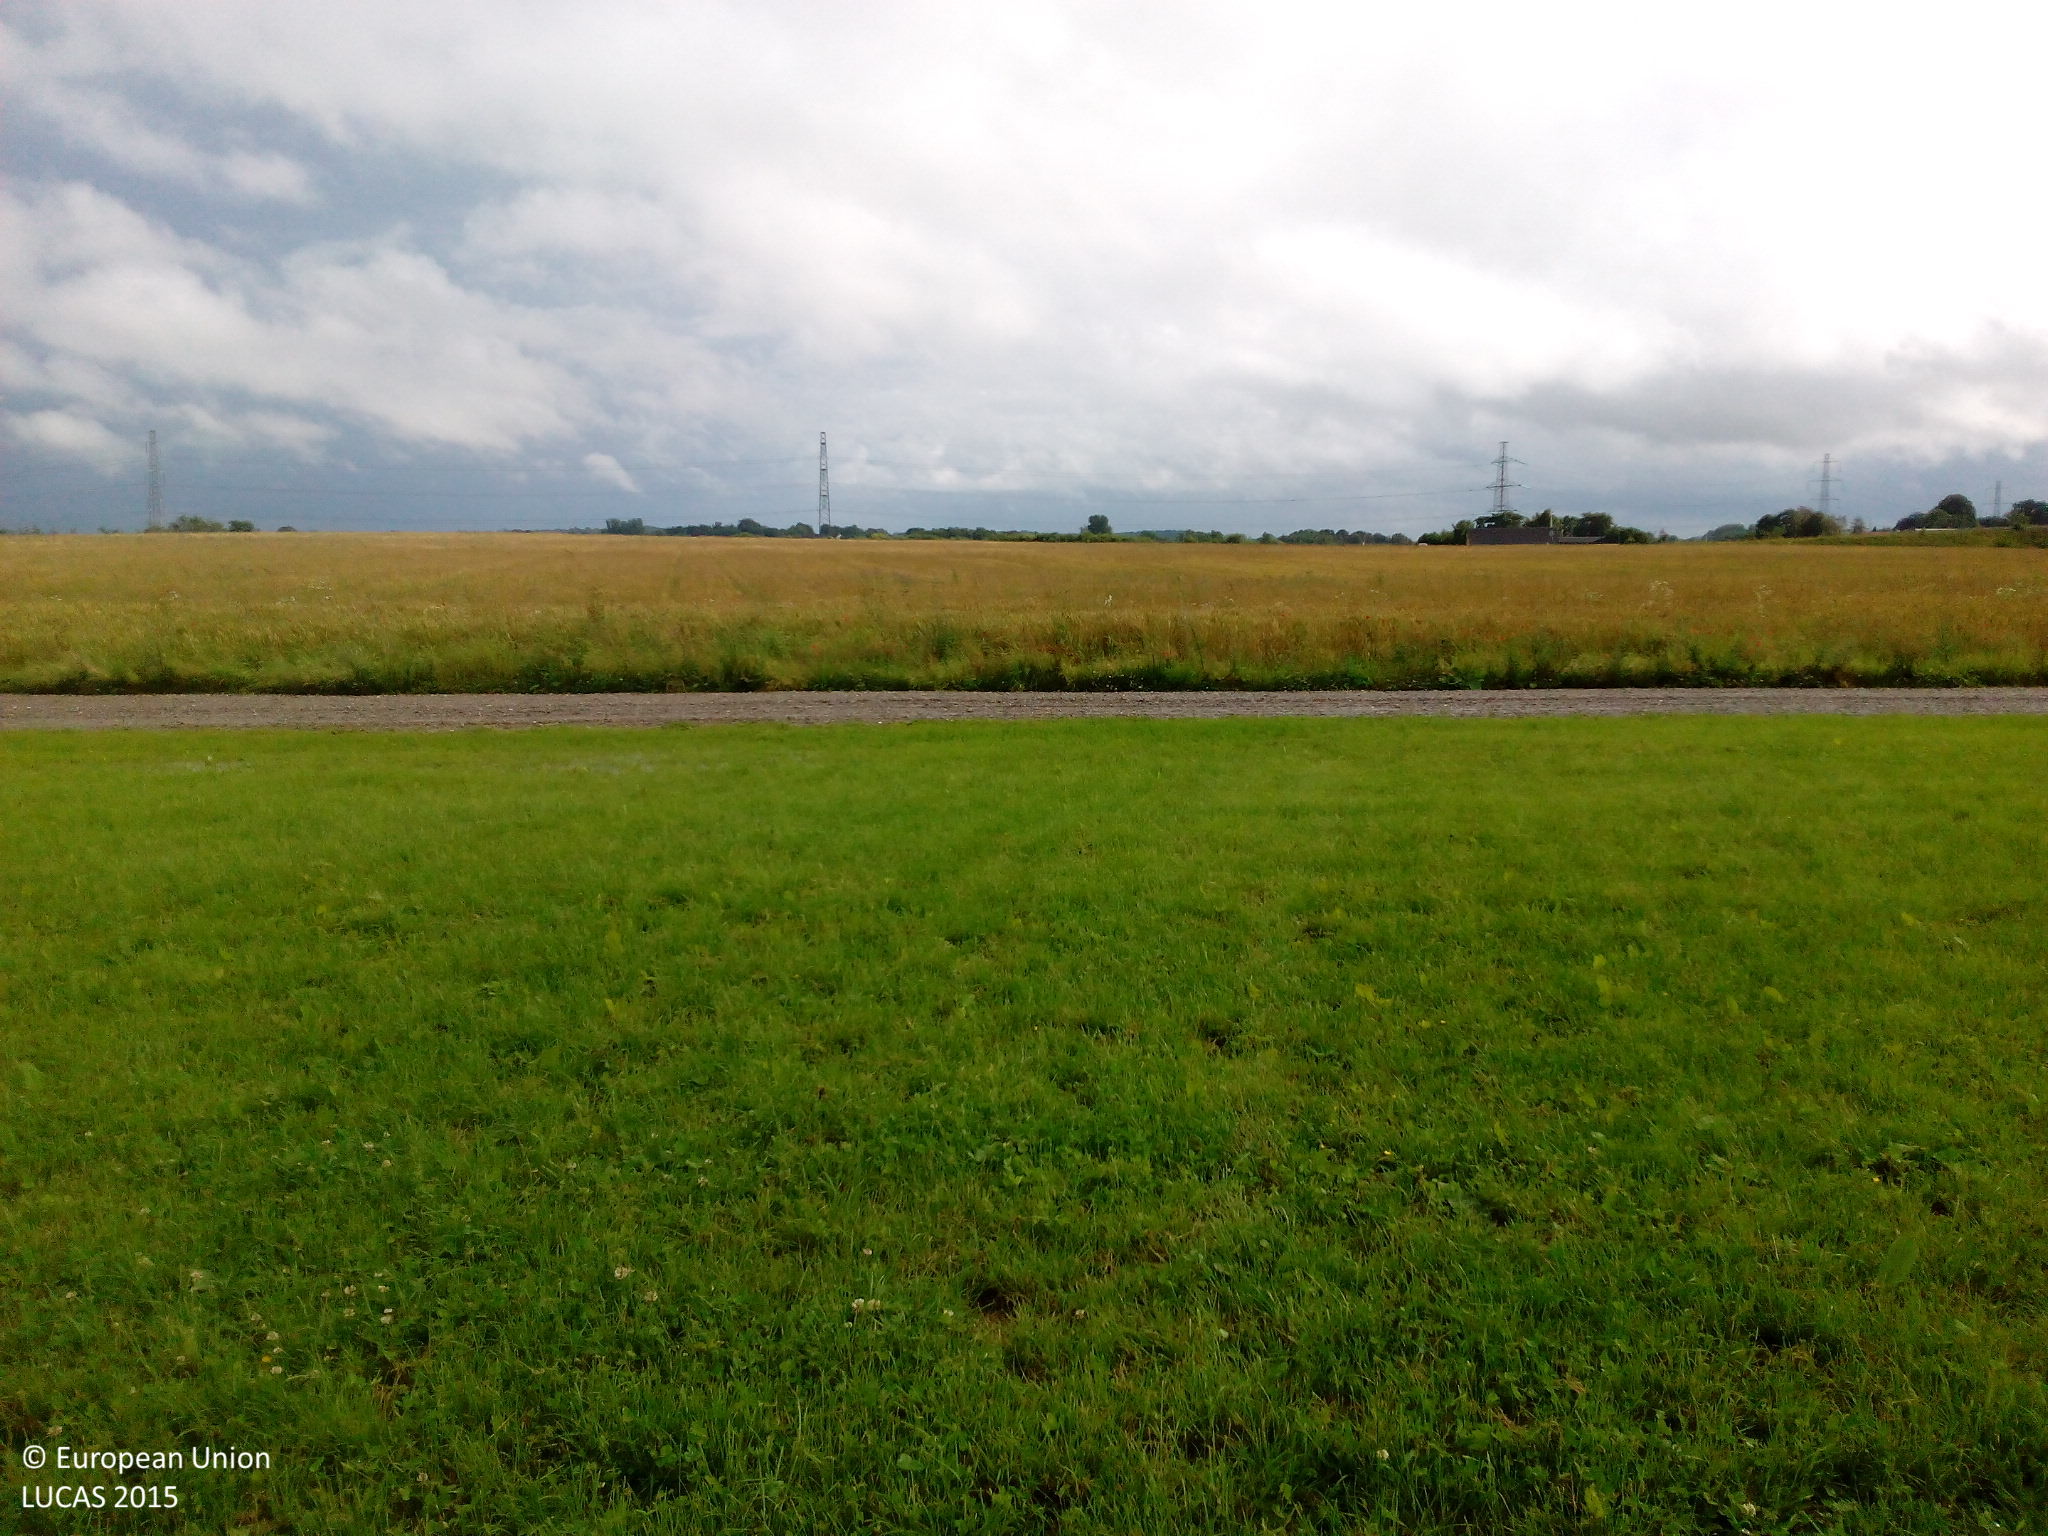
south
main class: Grassland
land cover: Grassland without tree/shrub cover
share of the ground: > 75 %
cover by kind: herbaceous plants 100 %
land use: Agriculture (excluding fallow land and kitchen gardens)
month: July
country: DK
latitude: 55.8994
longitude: 12.1890
